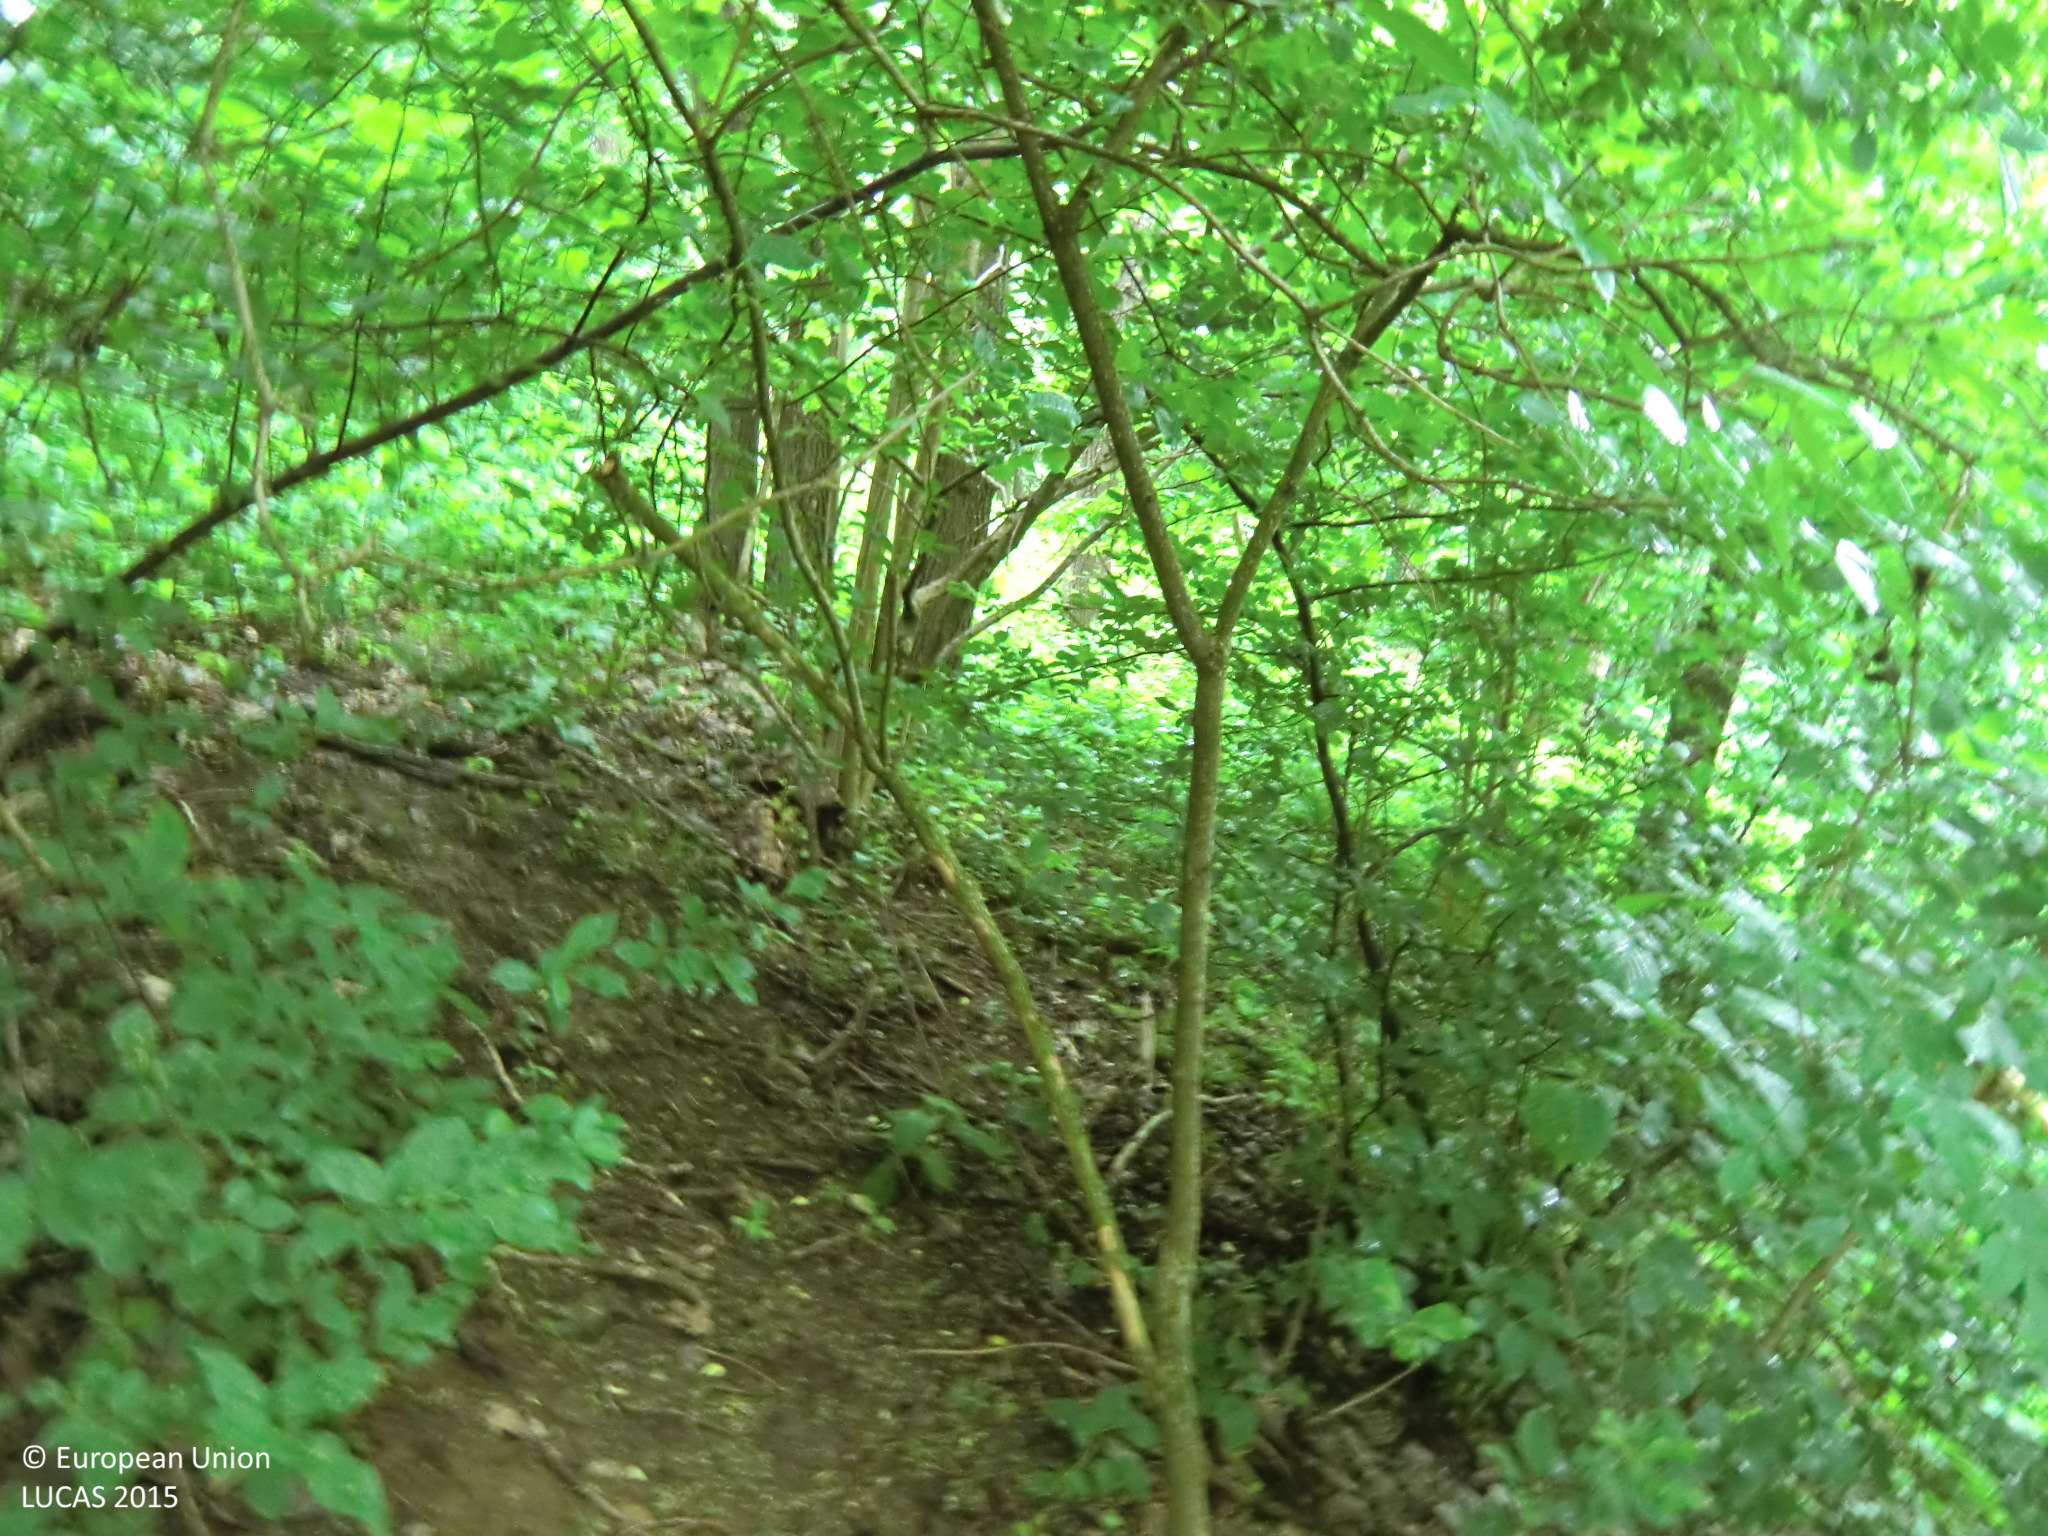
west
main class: Woodland
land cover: Broadleaved woodland
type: hemiboreal forest and nemoral coniferous forest and mixed broadleaved-coniferous forest
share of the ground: > 75 %
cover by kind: broadleaved forest trees 80 %, herbaceous plants 10 %, unconsolidated bare surface 10 %
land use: Forestry
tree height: > 5 m
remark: Temporary flooded
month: May
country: AT
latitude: 47.3025
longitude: 15.9930
